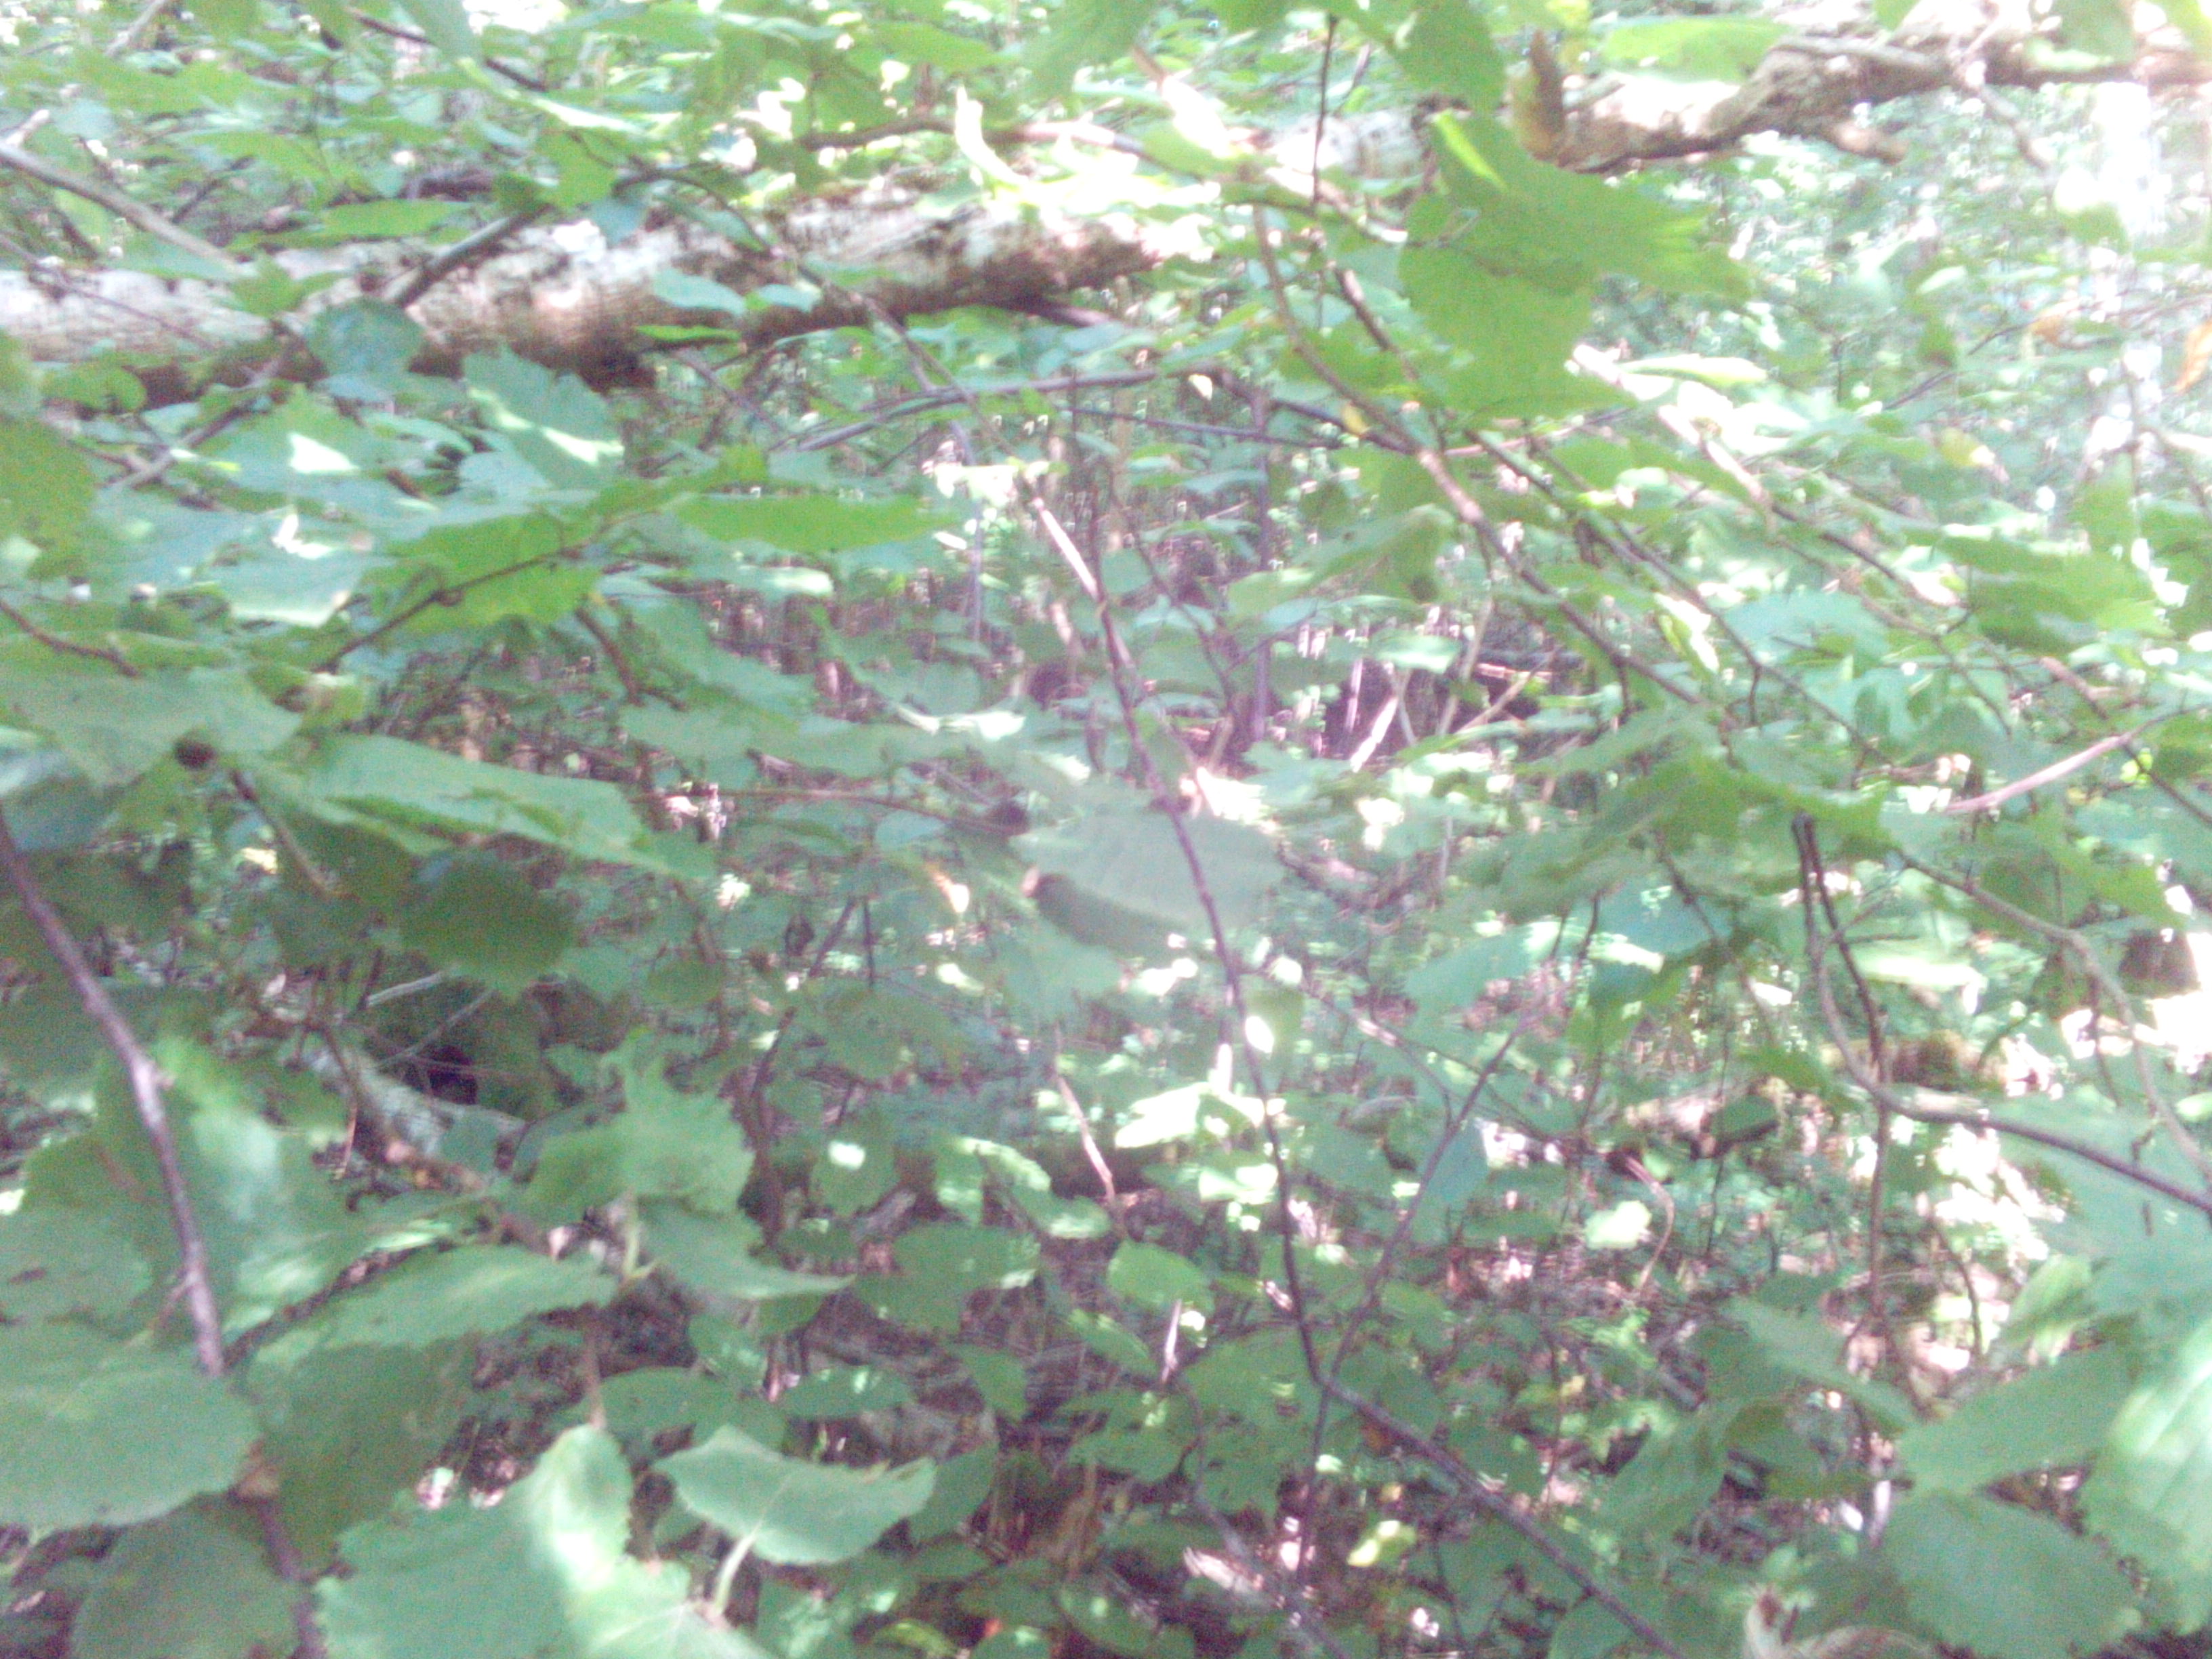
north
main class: Woodland
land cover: Broadleaved woodland
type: non-riverine alder, birch or aspen forest
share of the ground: > 75 %
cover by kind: broadleaved forest trees 95 %, herbaceous plants 5 %
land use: Forestry
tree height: > 5 m
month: August
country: LV
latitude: 56.4992
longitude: 21.3632
